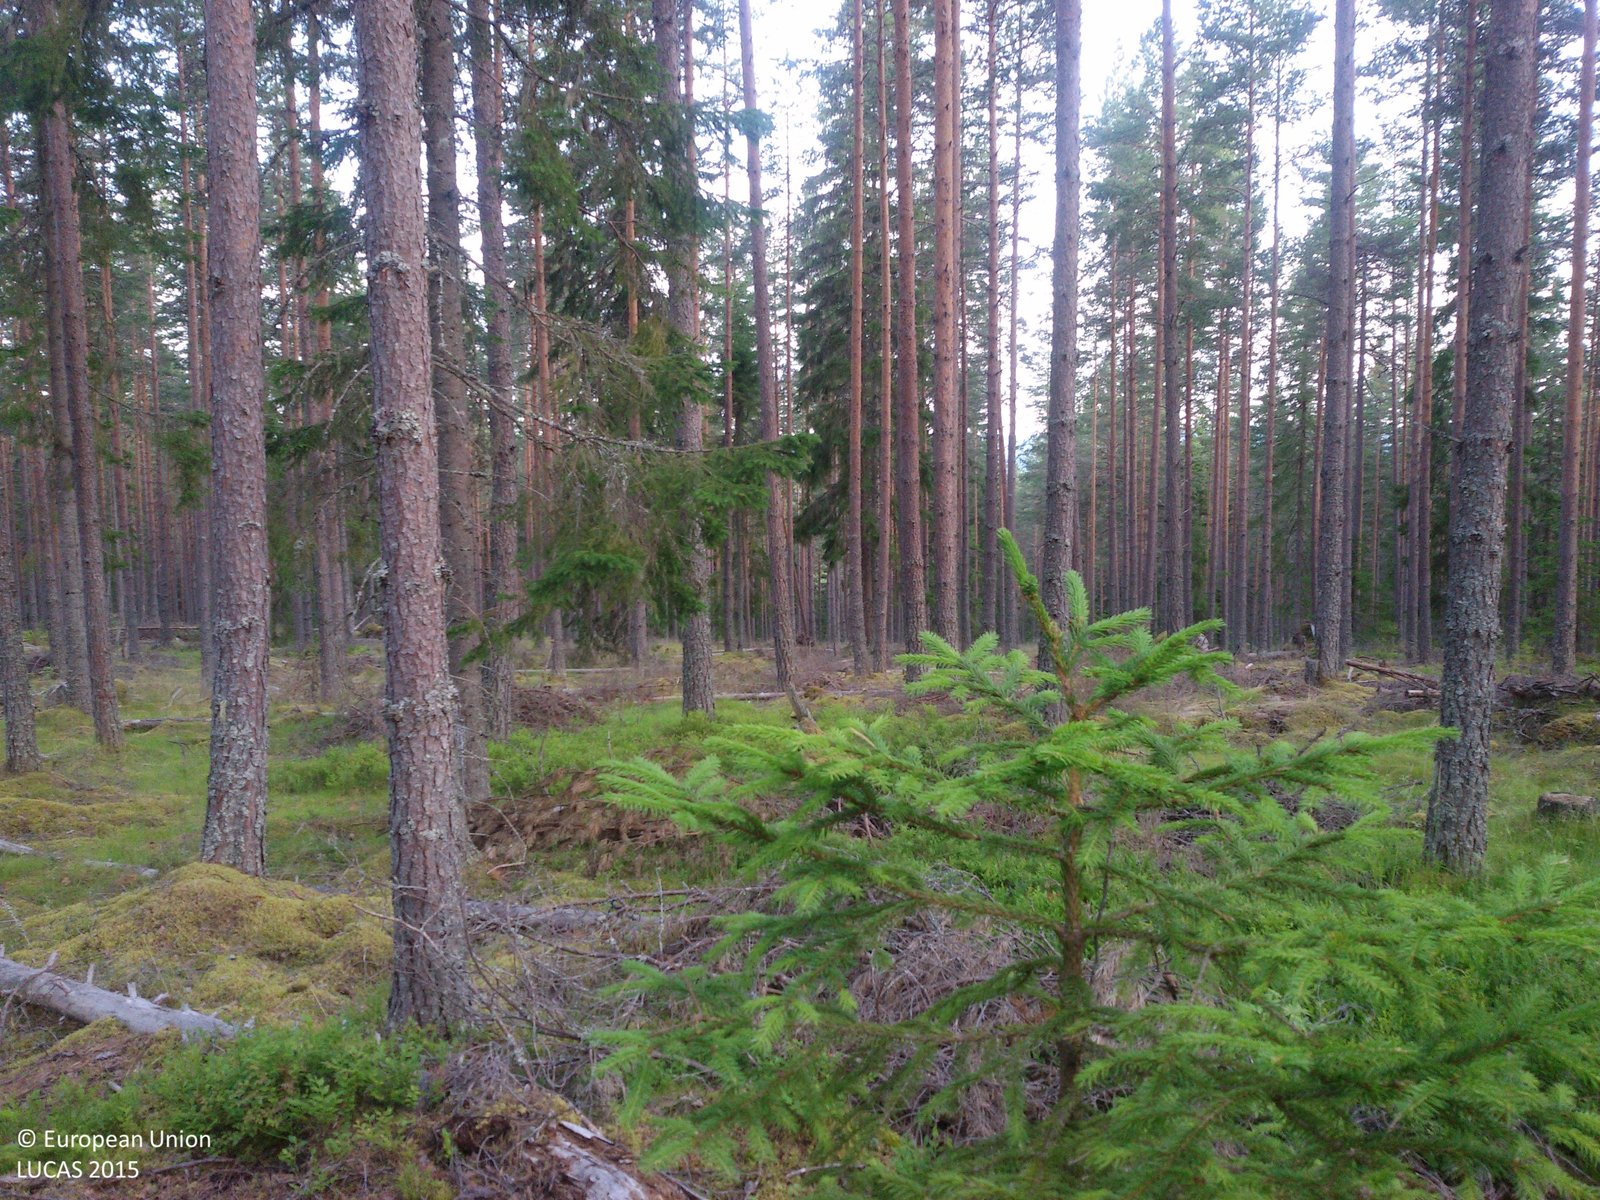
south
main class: Woodland
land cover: Pine dominated coniferous woodland
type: boreal forest
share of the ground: 50 - 75 %
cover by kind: coniferous forest trees 75 %, lichens and mosses 20 %, herbaceous plants 5 %
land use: Forestry
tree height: > 5 m
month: July
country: SE
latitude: 60.5264
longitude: 14.9619
